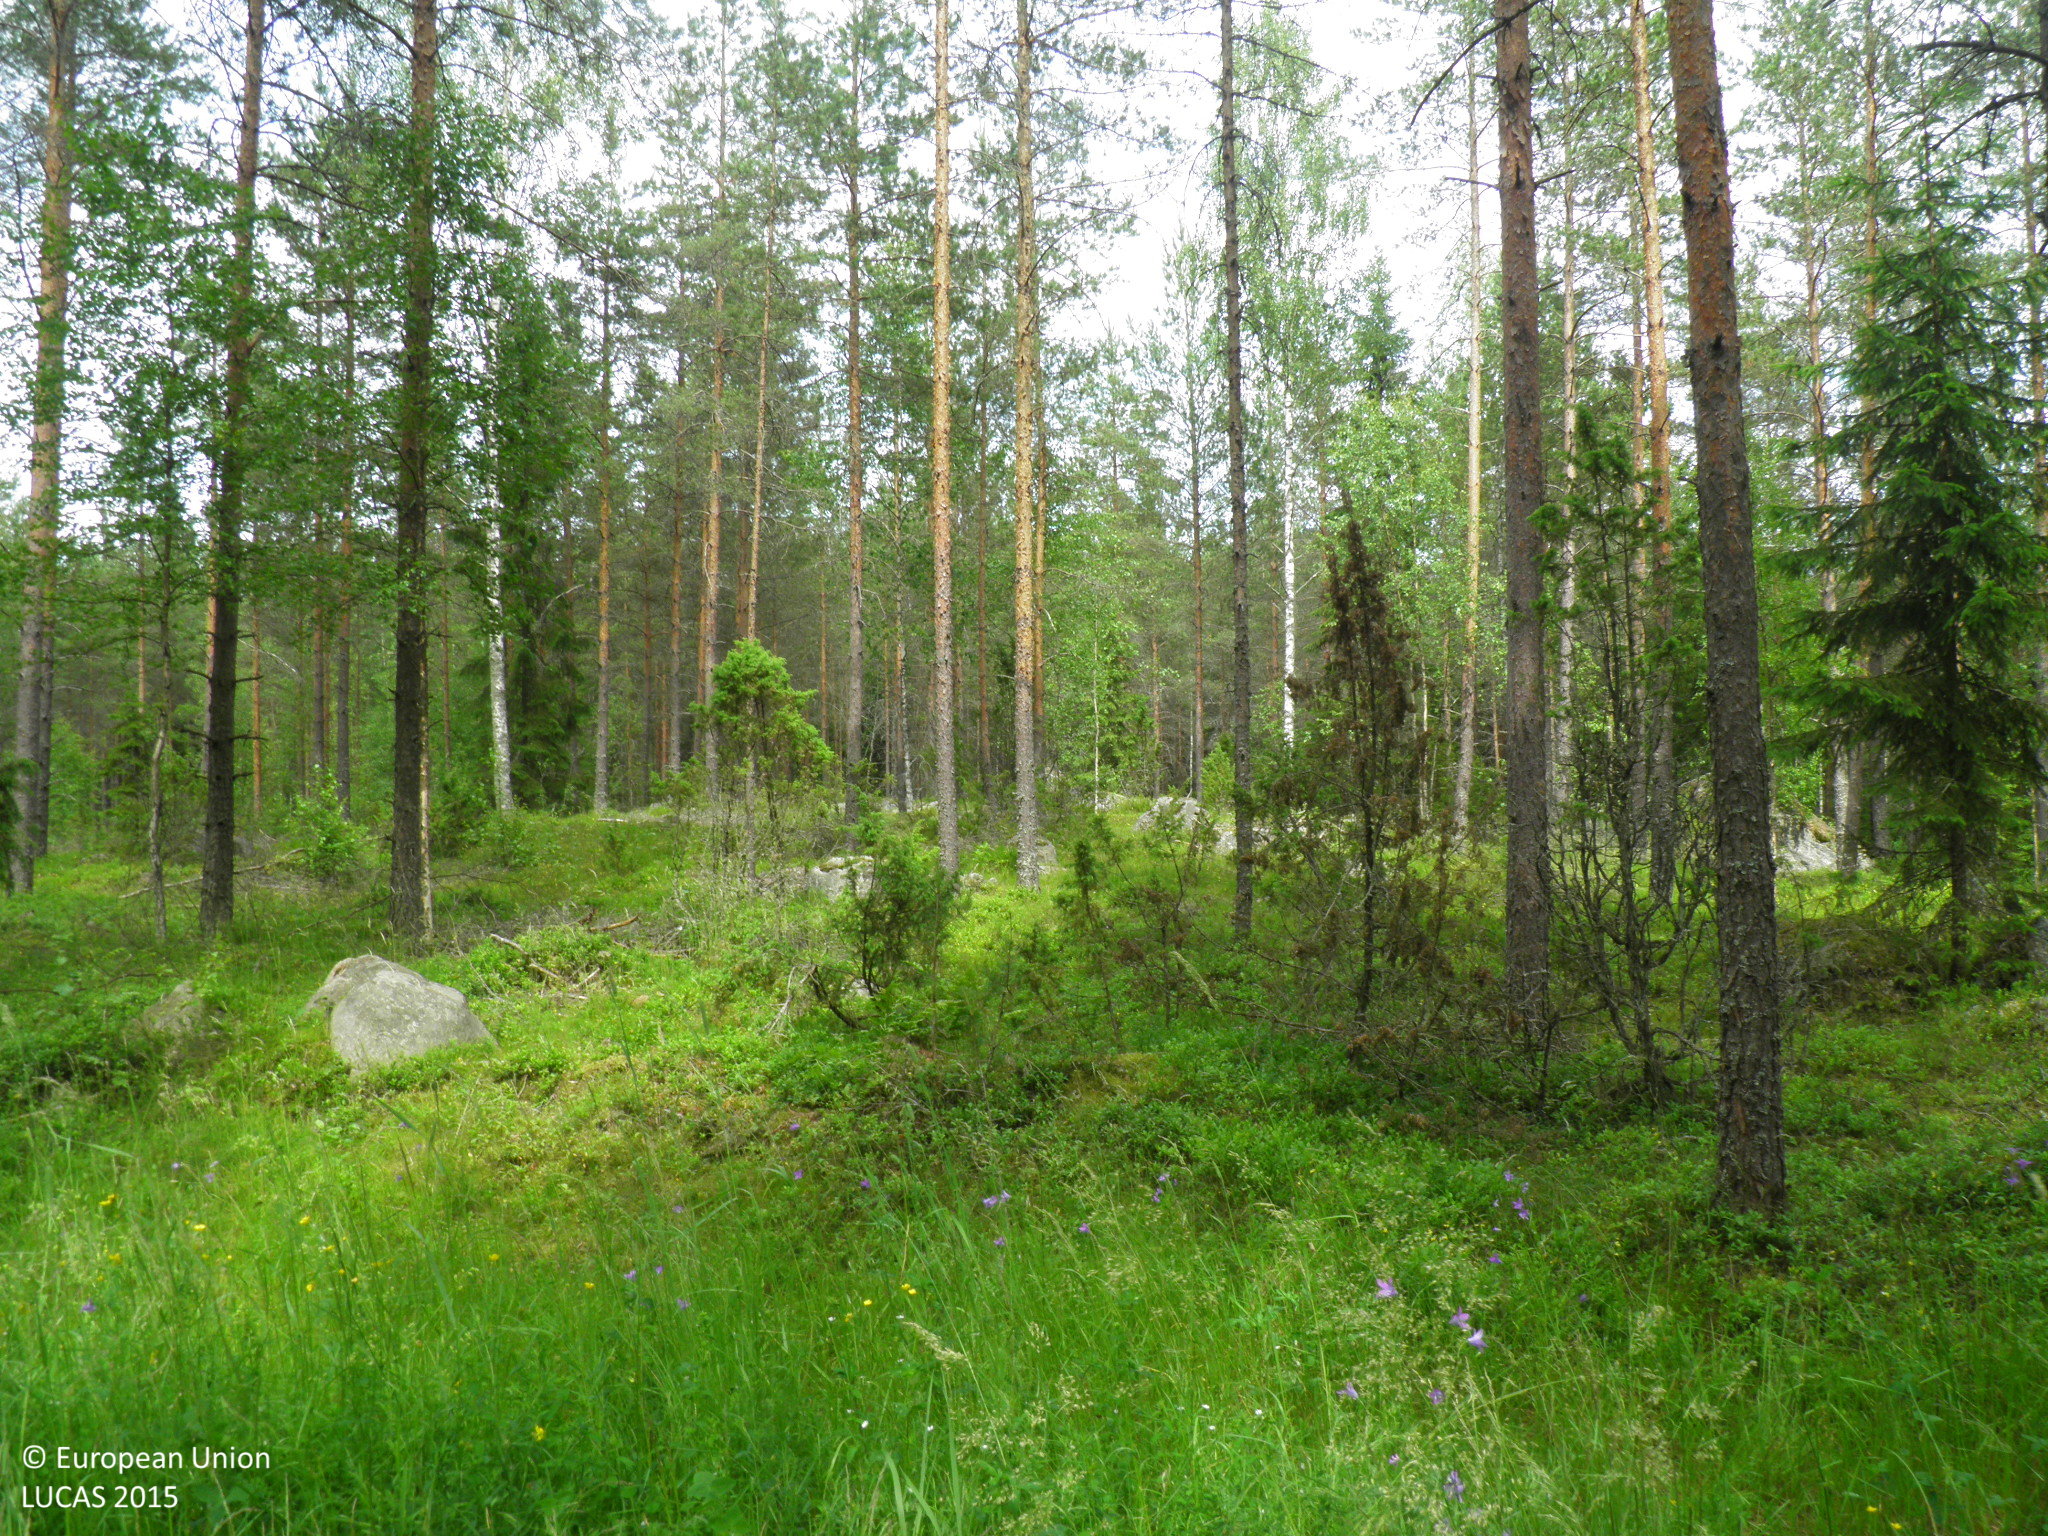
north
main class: Woodland
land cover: Pine dominated coniferous woodland
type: boreal forest
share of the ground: 50 - 75 %
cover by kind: coniferous forest trees 55 %, broadleaved forest trees 15 %, shrubs 15 %, herbaceous plants 15 %
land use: Forestry
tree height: > 5 m
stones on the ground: < 10 %
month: July
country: FI
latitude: 60.7215
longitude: 22.6644
